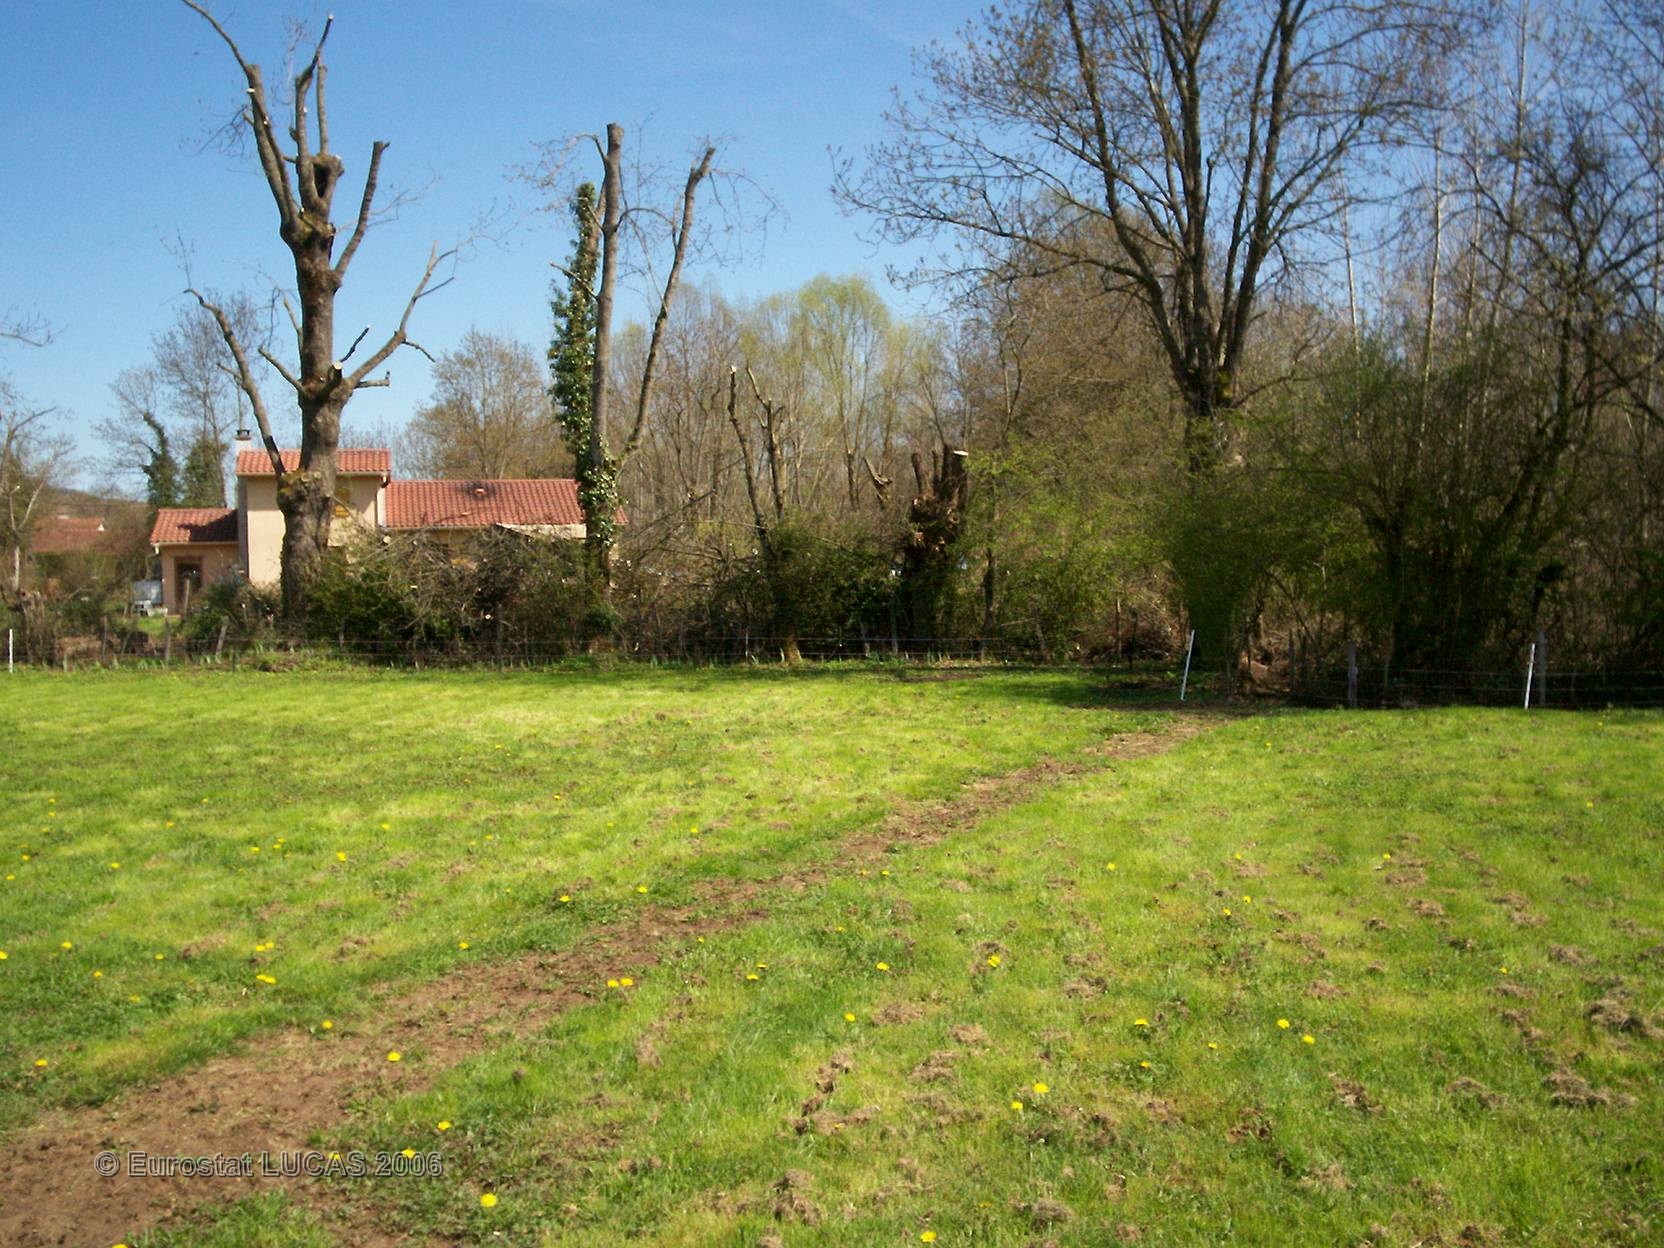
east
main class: Grassland
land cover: Grassland without tree/shrub cover
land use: Residential
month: April
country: FR
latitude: 46.4212
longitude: 4.7583
